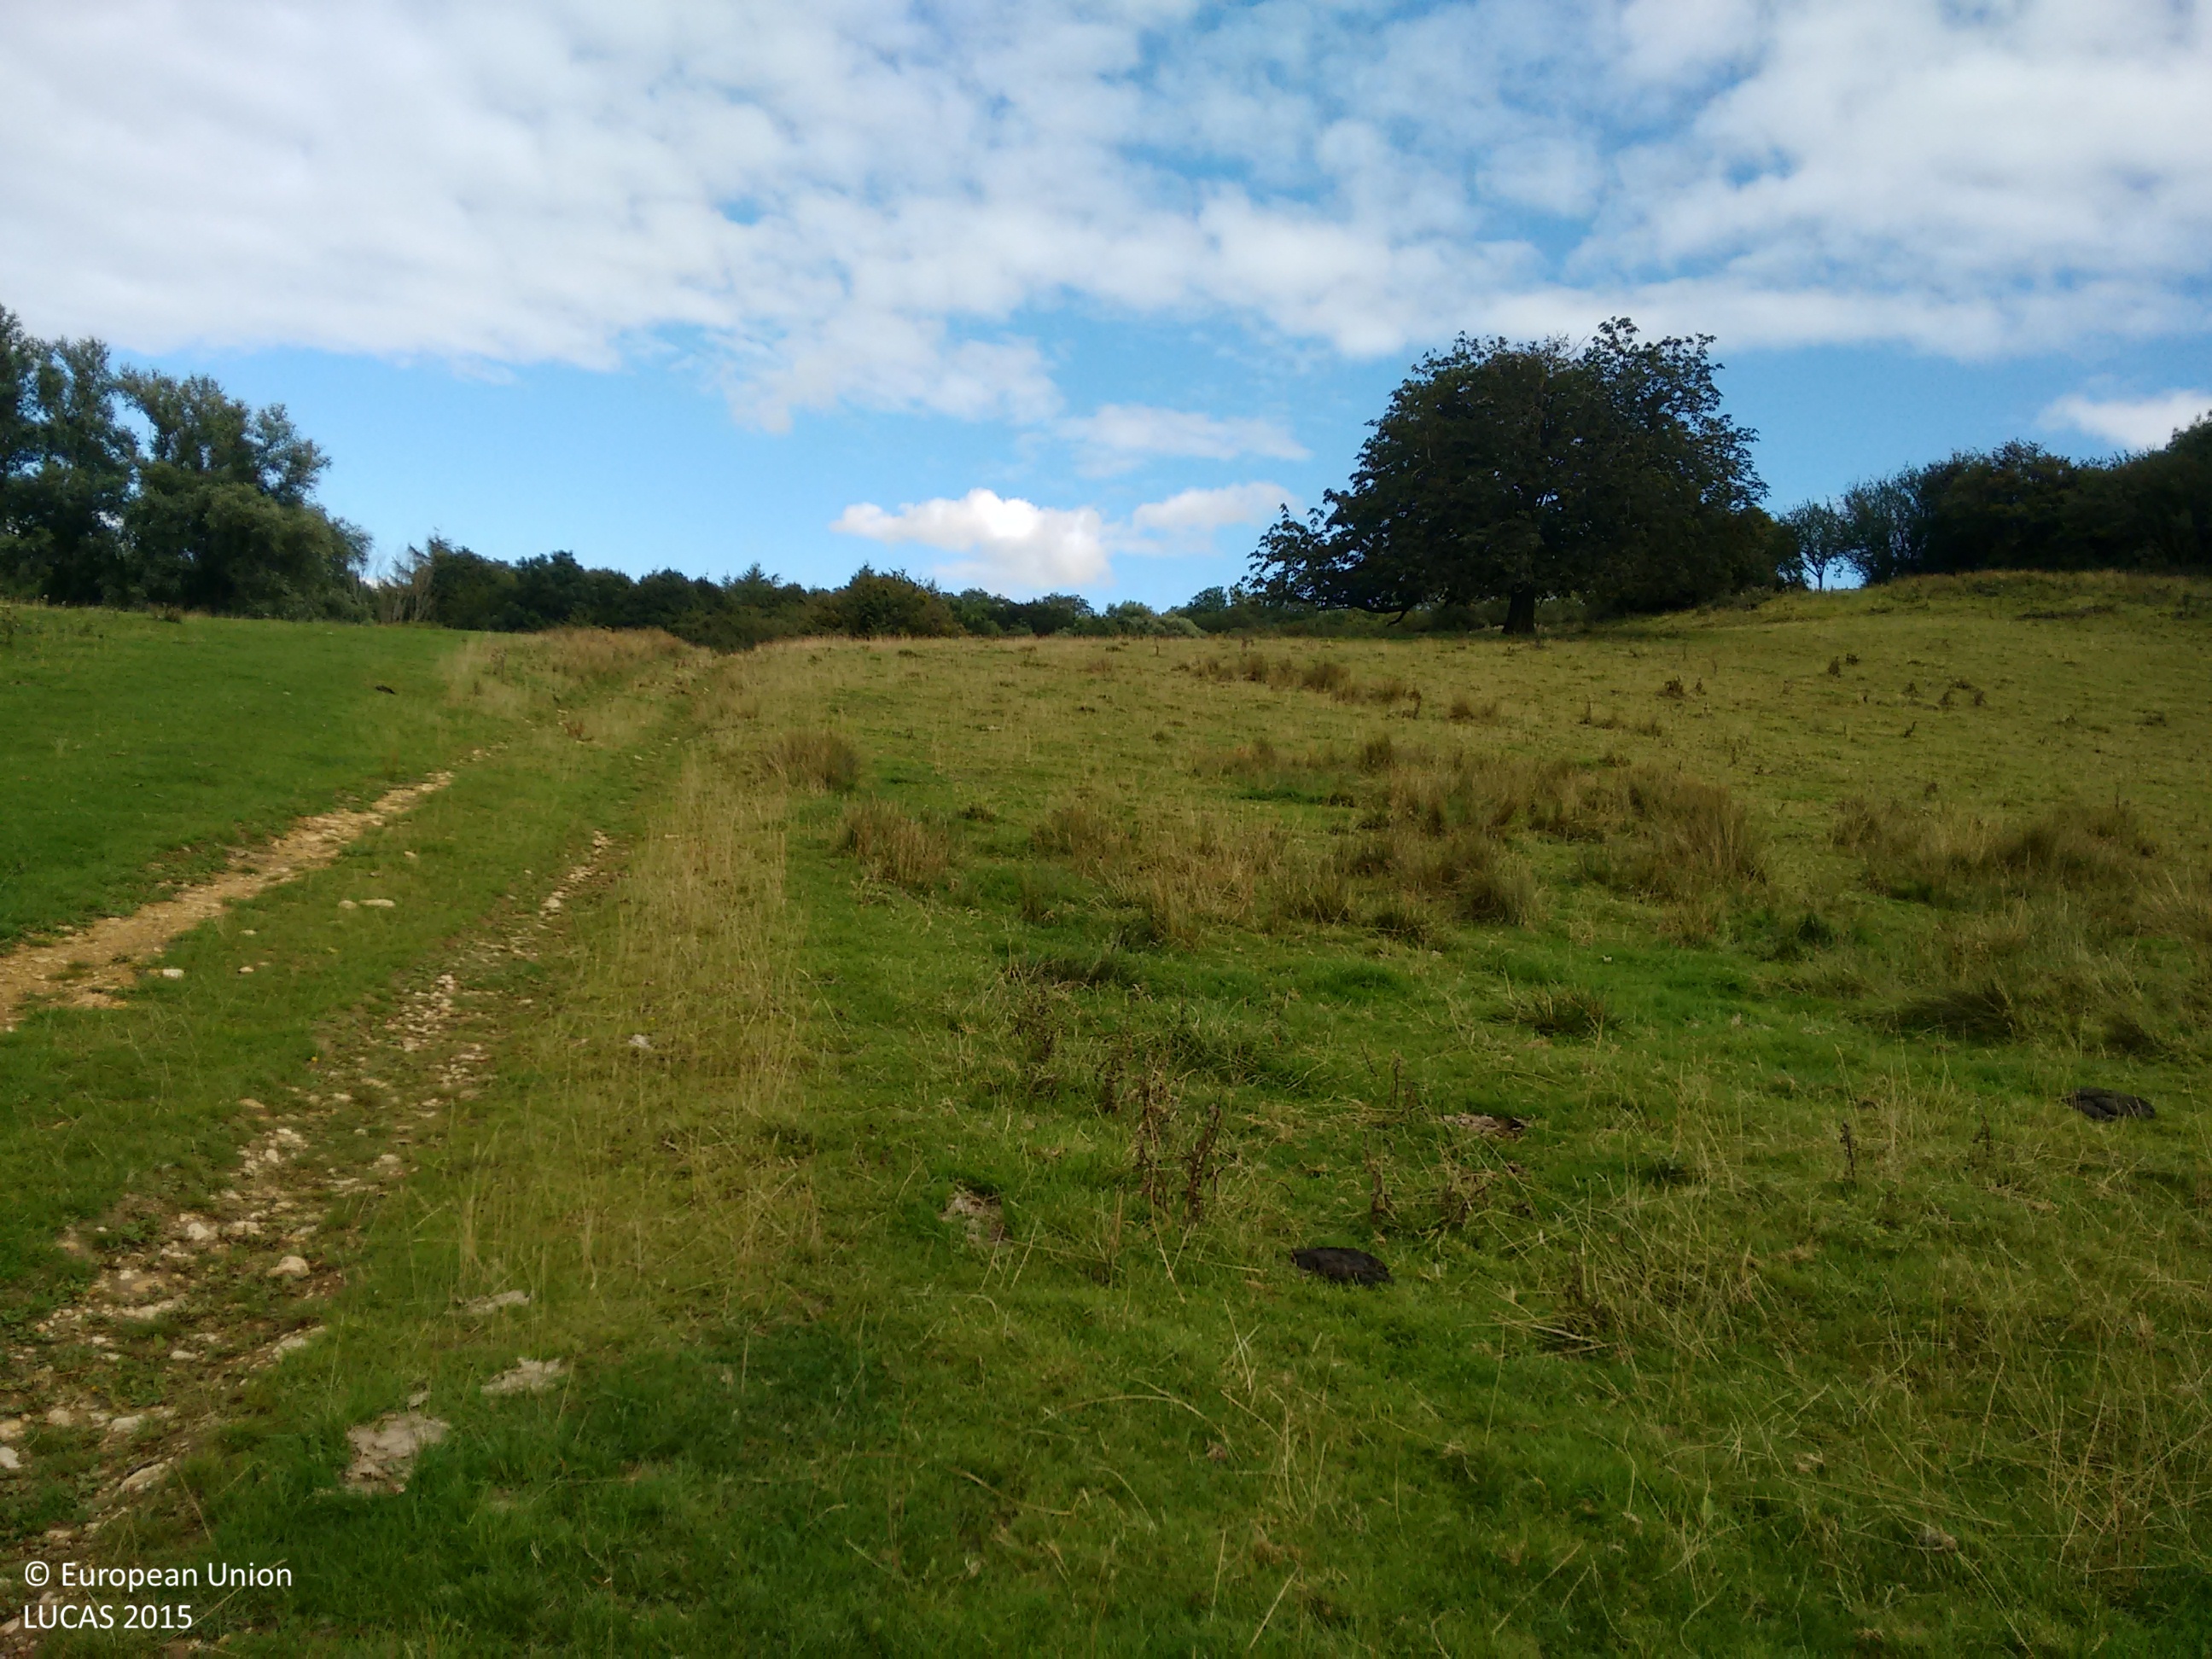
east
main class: Grassland
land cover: Grassland without tree/shrub cover
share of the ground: > 75 %
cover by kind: herbaceous plants 100 %
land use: Agriculture (excluding fallow land and kitchen gardens)
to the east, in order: Grassland without tree/shrub cover; Tracks; Grassland without tree/shrub cover; Single bushes/trees; Grassland without tree/shrub cover; Abandoned hedges; Grassland without tree/shrub cover; Tracks; Grass margins; Fences; Broadleaved woodland
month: September
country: GB
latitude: 51.9623
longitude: -2.0366
